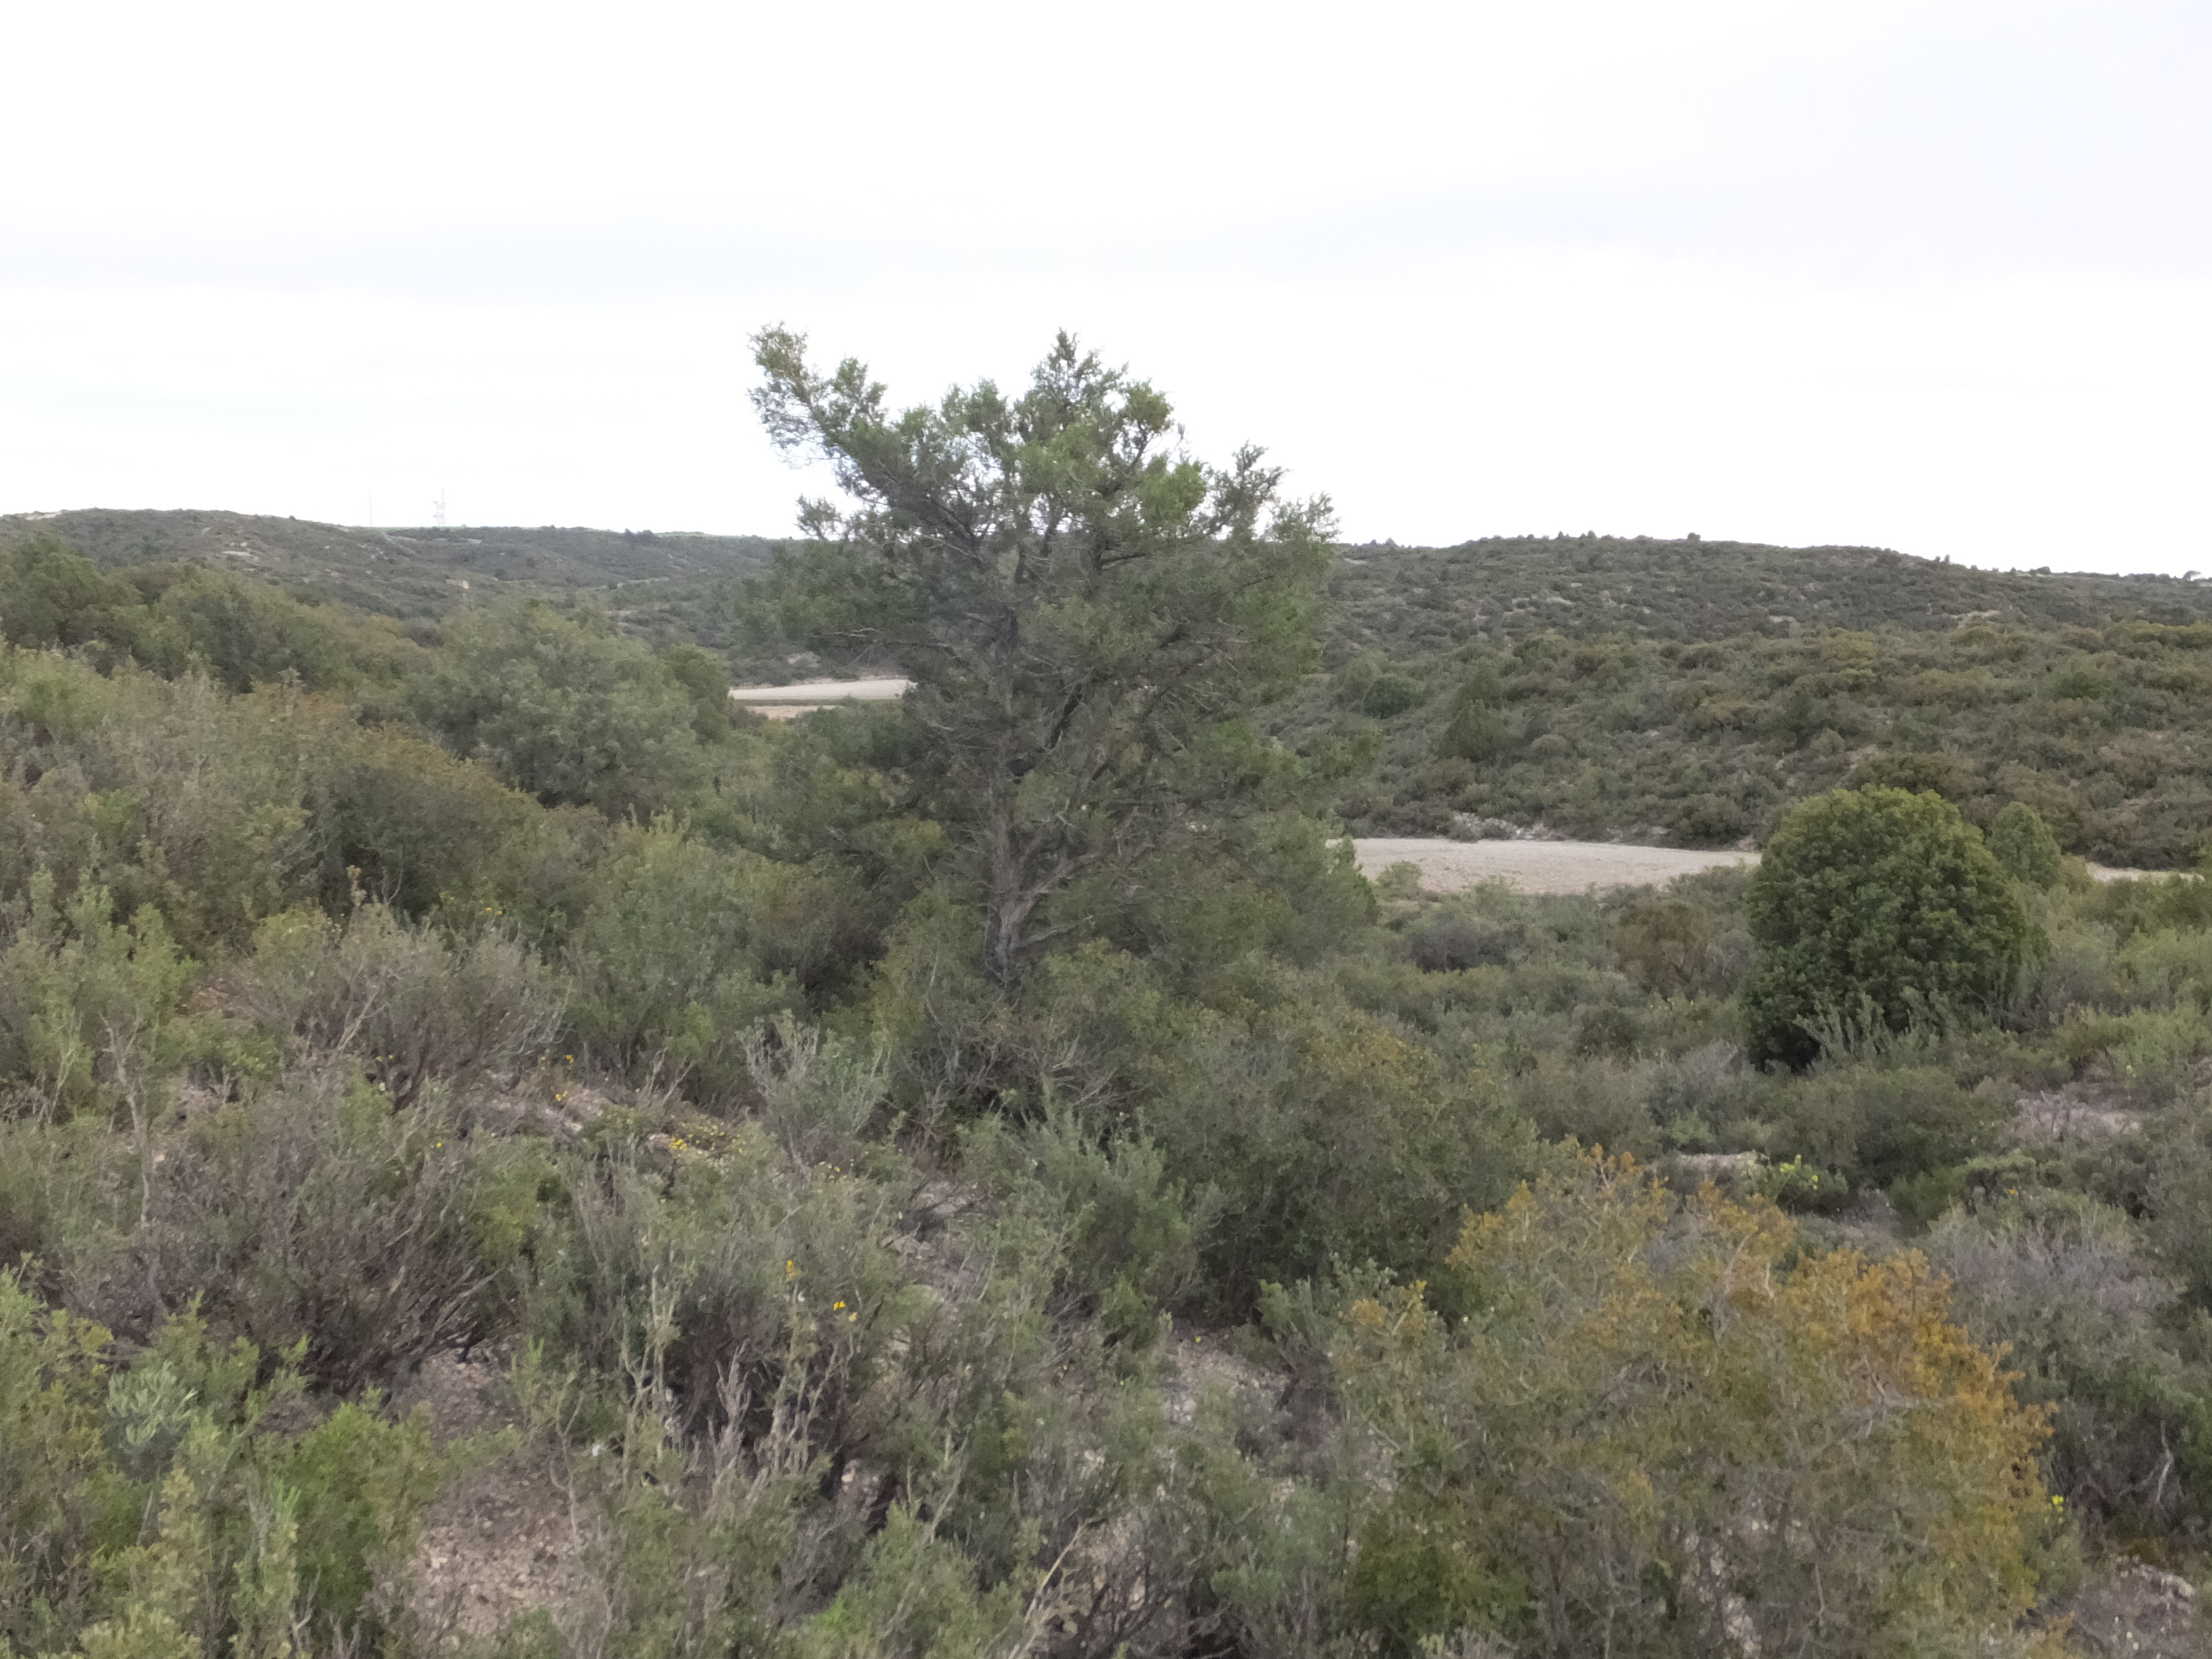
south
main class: Shrubland
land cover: Shrubland with sparse tree cover
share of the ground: > 75 %
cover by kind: shrubs 95 %, coniferous forest trees 5 %
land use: Semi-natural and natural areas not in use
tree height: < 5 m
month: April
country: ES
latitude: 41.6357
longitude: -0.3055
